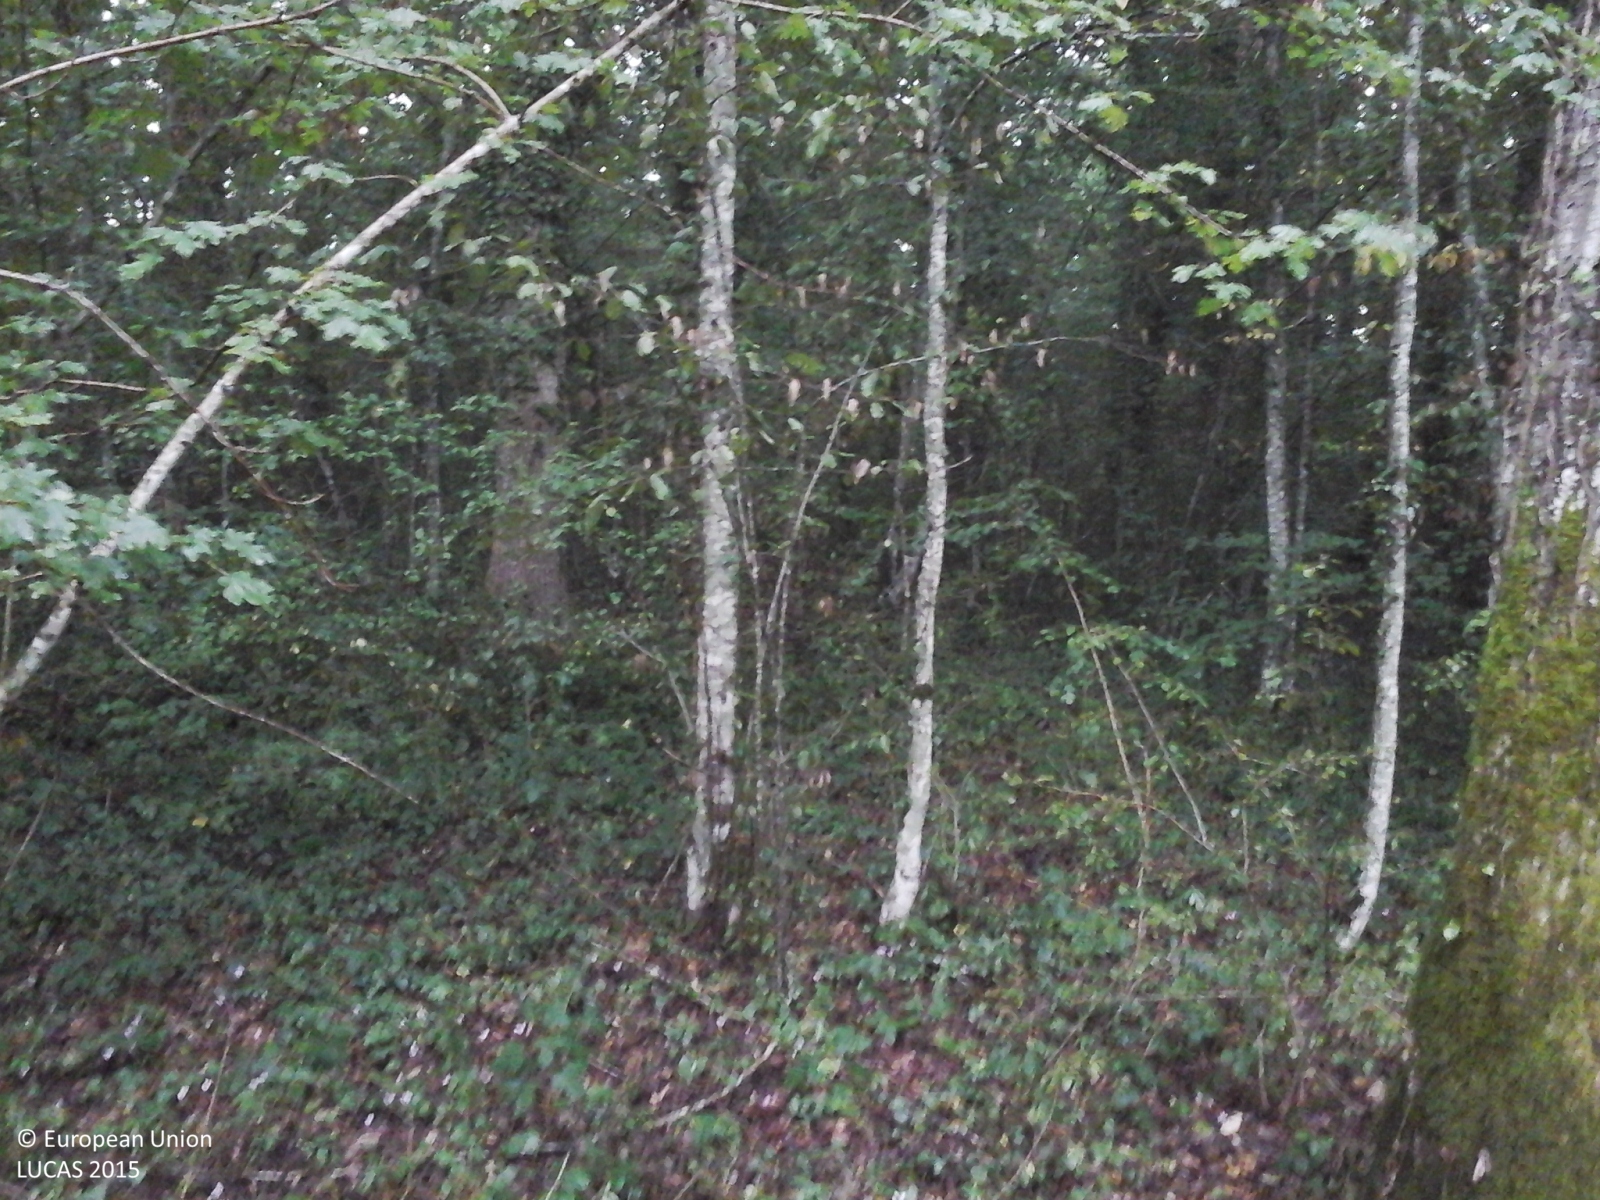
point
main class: Woodland
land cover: Broadleaved woodland
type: thermophilous deciduous forest
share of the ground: > 75 %
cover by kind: broadleaved forest trees 85 %, herbaceous plants 10 %, shrubs 5 %
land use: Forestry
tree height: > 5 m
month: September
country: IT
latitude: 41.7094
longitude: 14.3716
